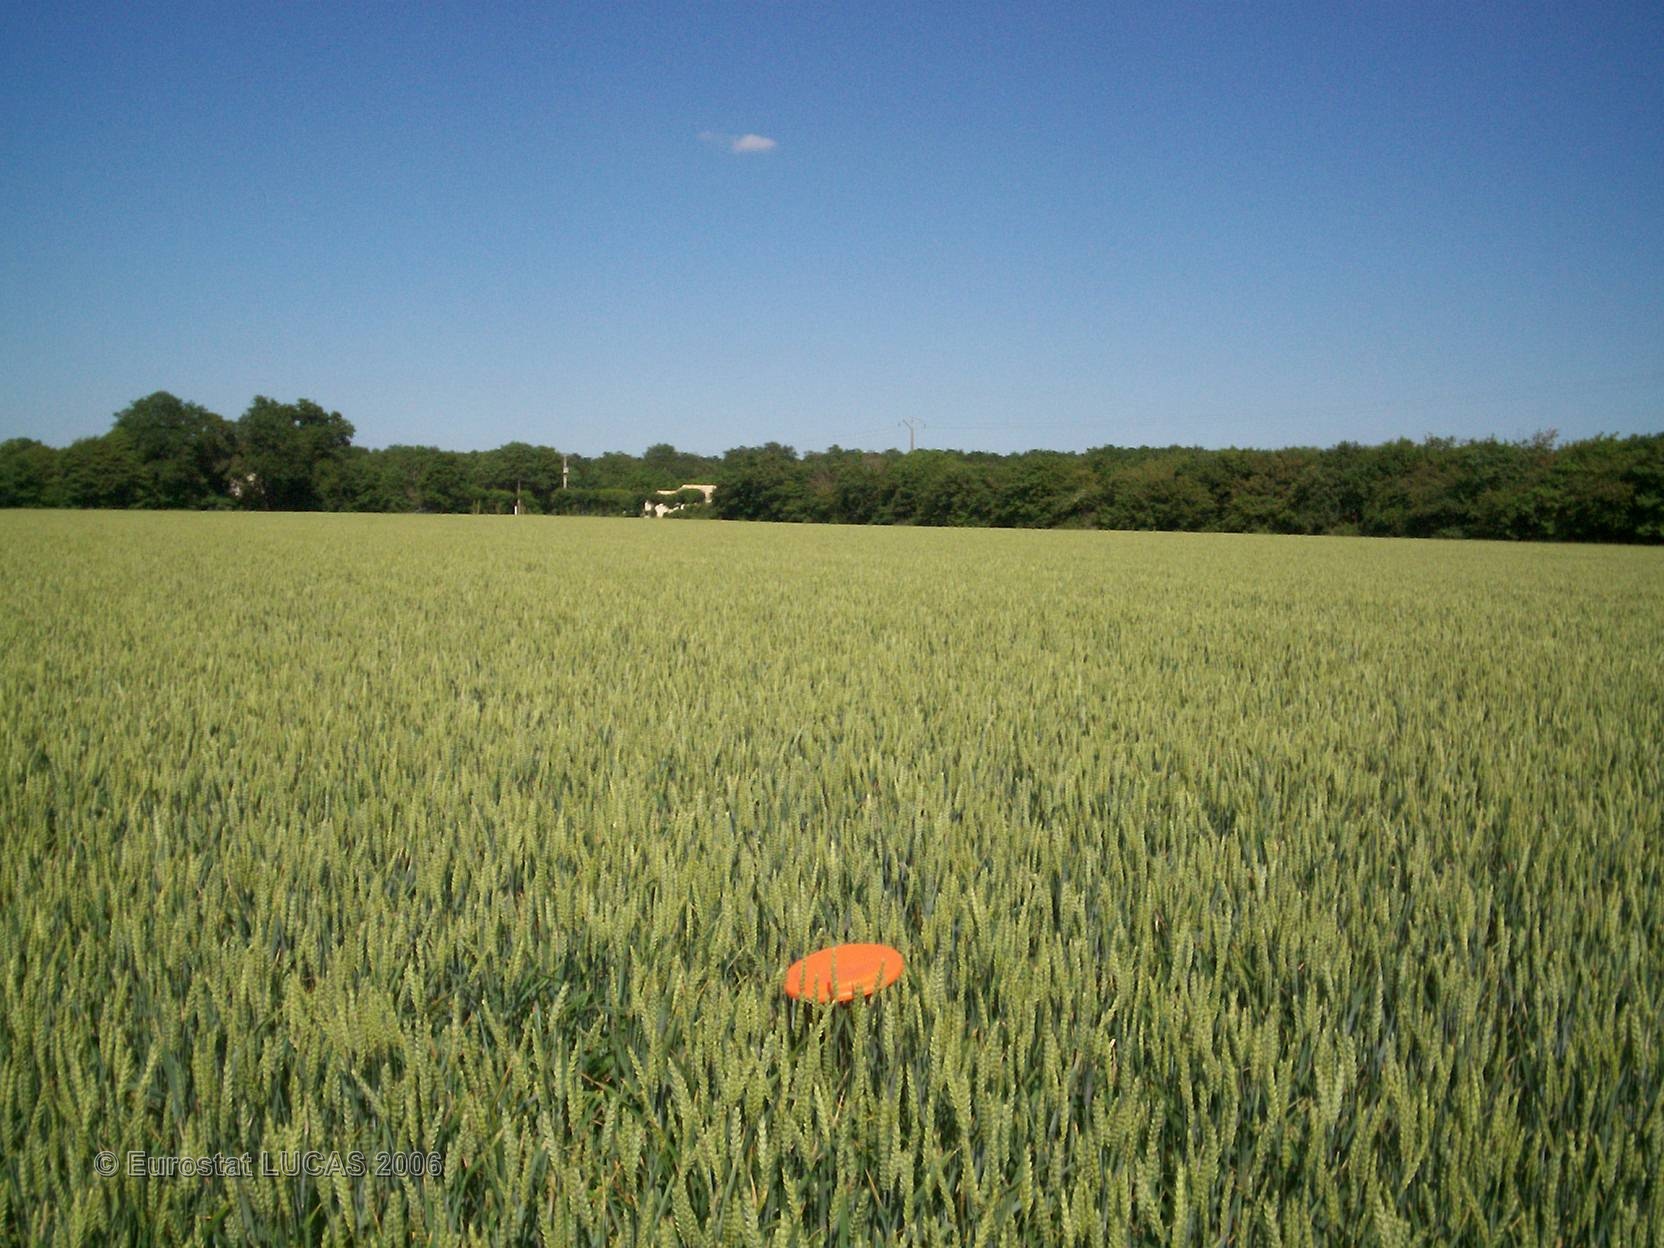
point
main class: Cropland
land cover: Common wheat
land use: Agriculture (excluding fallow land and kitchen gardens)
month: June
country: FR
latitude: 46.1874
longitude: -0.7685
